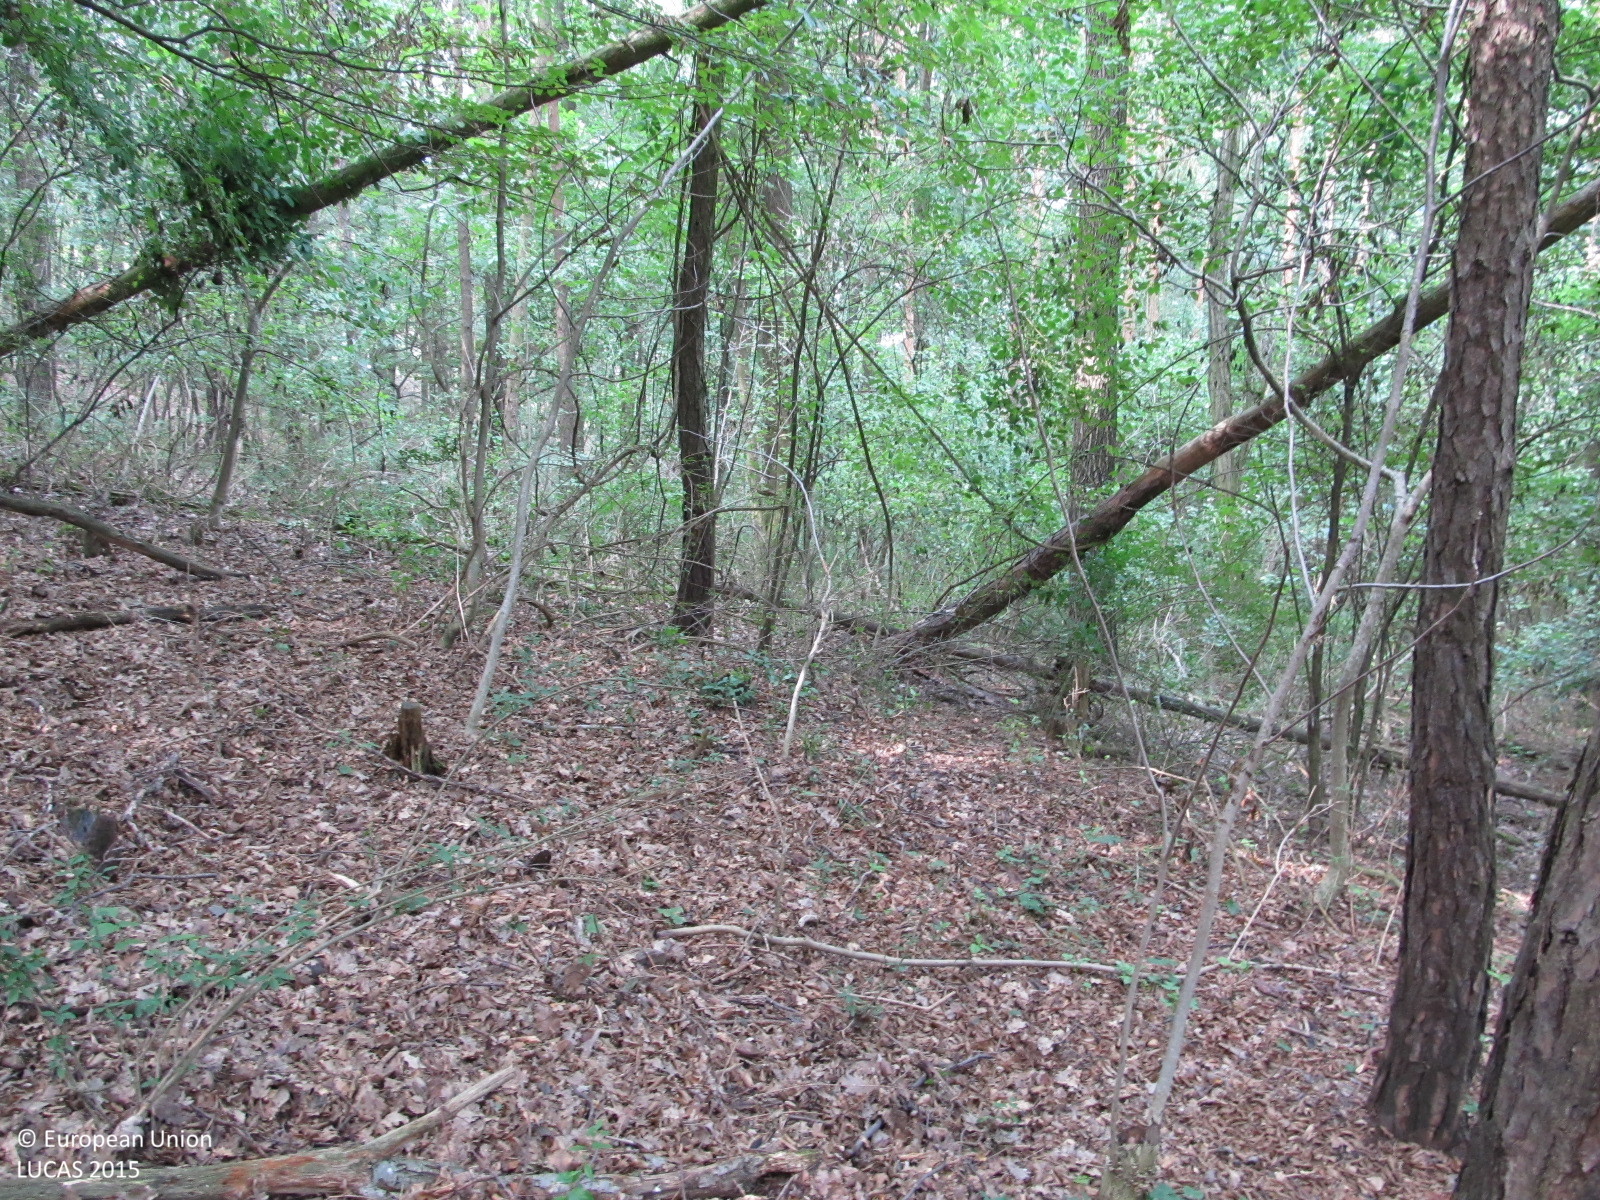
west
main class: Woodland
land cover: Other mixed woodland
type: hemiboreal forest and nemoral coniferous forest and mixed broadleaved-coniferous forest
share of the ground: > 75 %
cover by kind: broadleaved forest trees 60 %, coniferous forest trees 20 %, herbaceous plants 10 %, unconsolidated bare surface 10 %
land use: Forestry
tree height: > 5 m
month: September
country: AT
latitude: 48.3323
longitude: 15.6279
